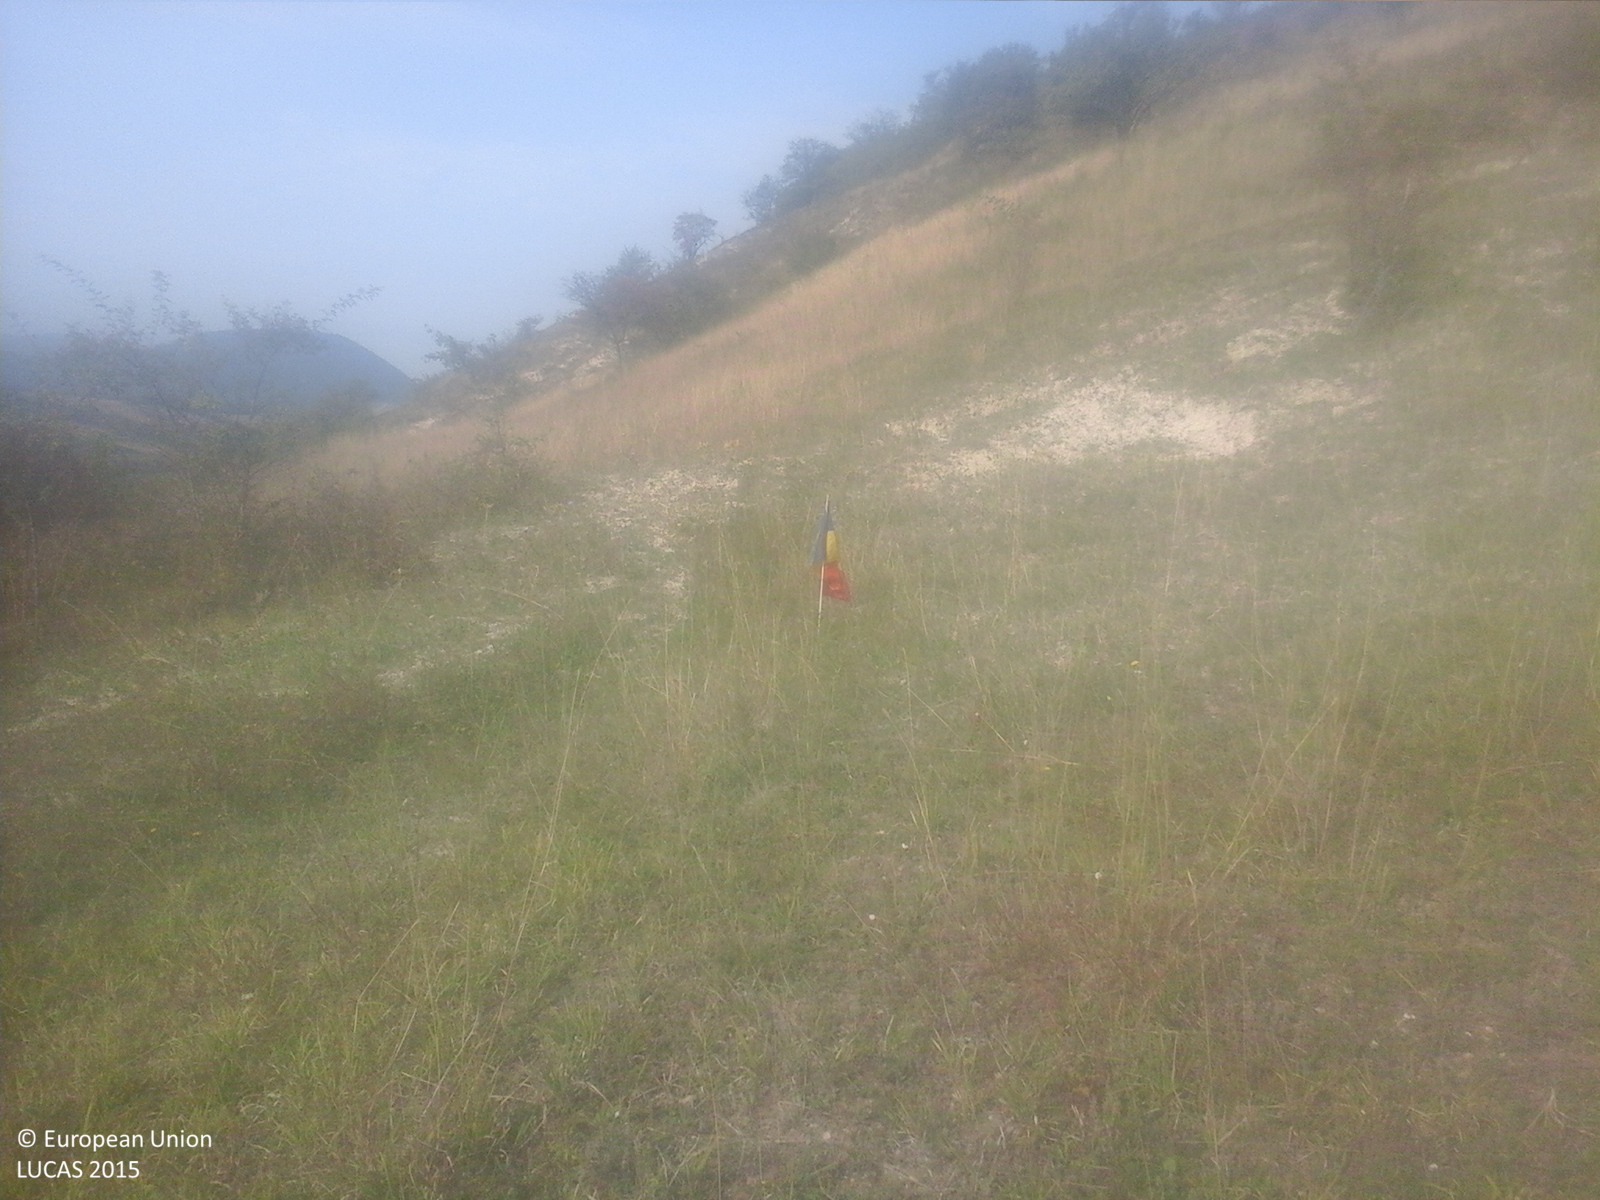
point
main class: Grassland
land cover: Grassland without tree/shrub cover
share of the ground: > 75 %
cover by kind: herbaceous plants 100 %
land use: Agriculture (excluding fallow land and kitchen gardens)
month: September
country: RO
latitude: 47.2064
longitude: 23.2028
